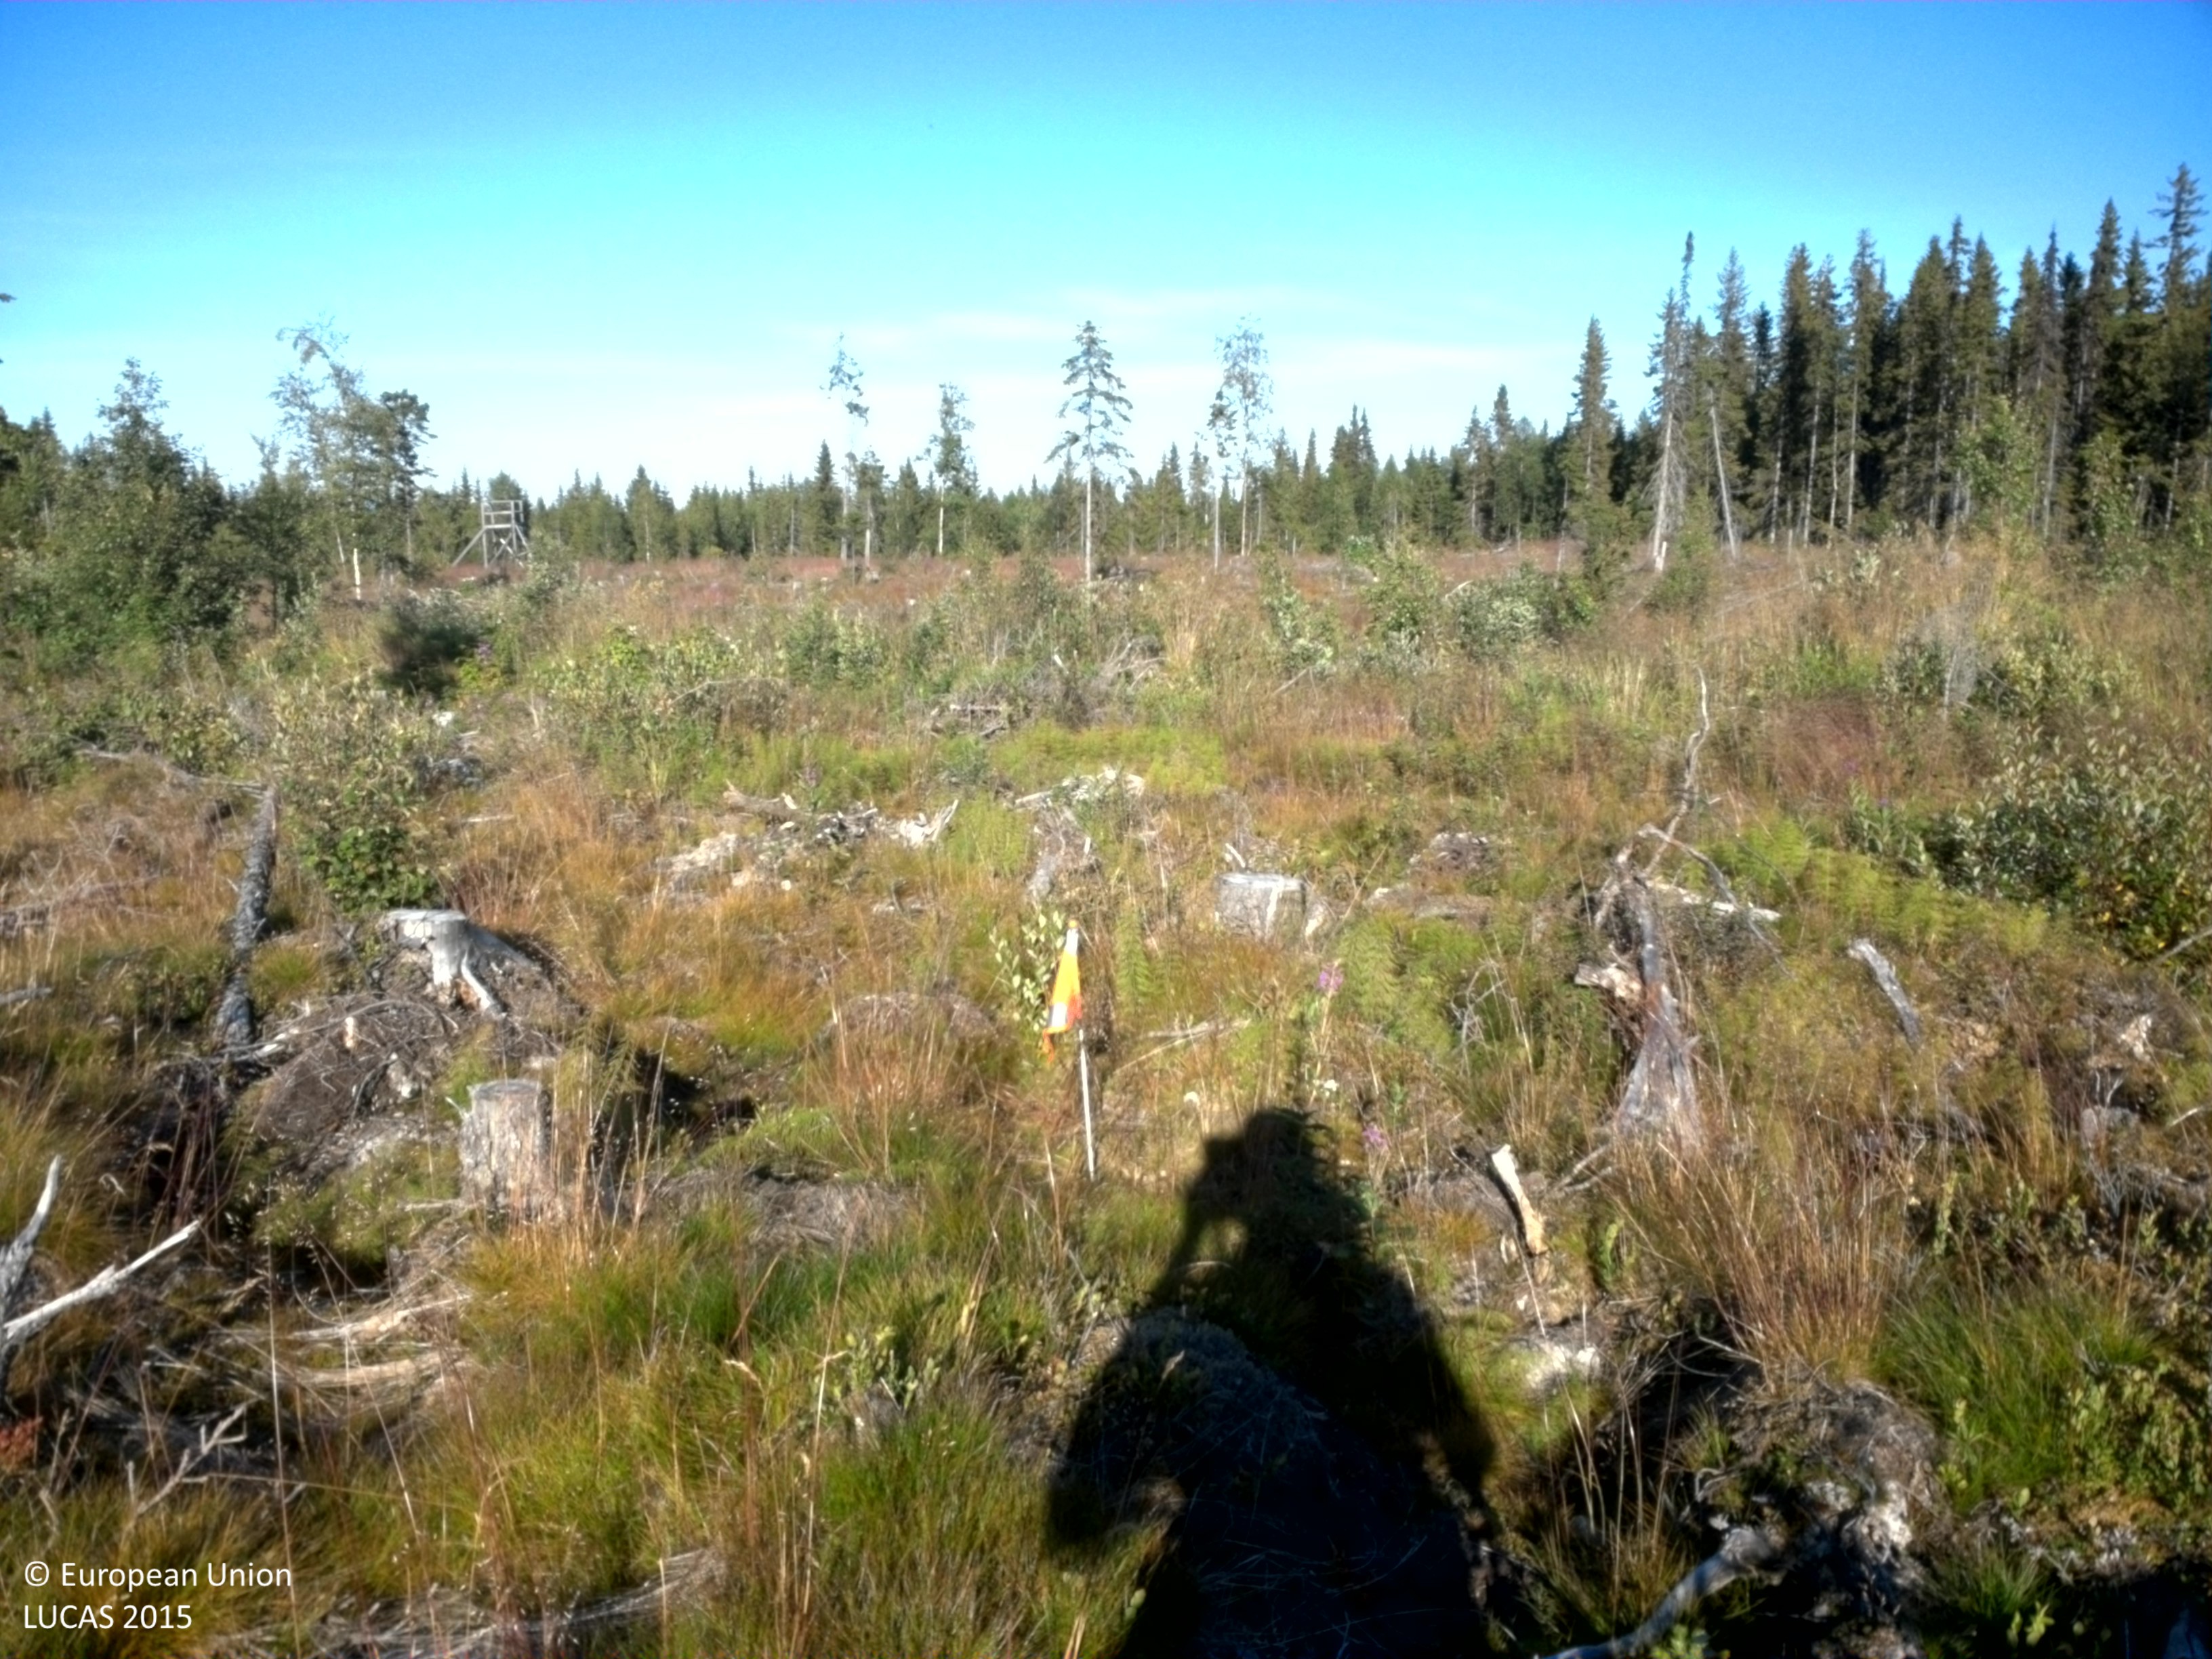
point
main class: Grassland
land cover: Grassland with sparse tree/shrub cover
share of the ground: > 75 %
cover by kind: herbaceous plants 85 %, broadleaved forest trees 5 %, shrubs 5 %, lichens and mosses 5 %
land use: Forestry
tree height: < 5 m
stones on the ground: < 10 %
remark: Clear cut
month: August
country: SE
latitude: 64.6760
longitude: 16.1905
